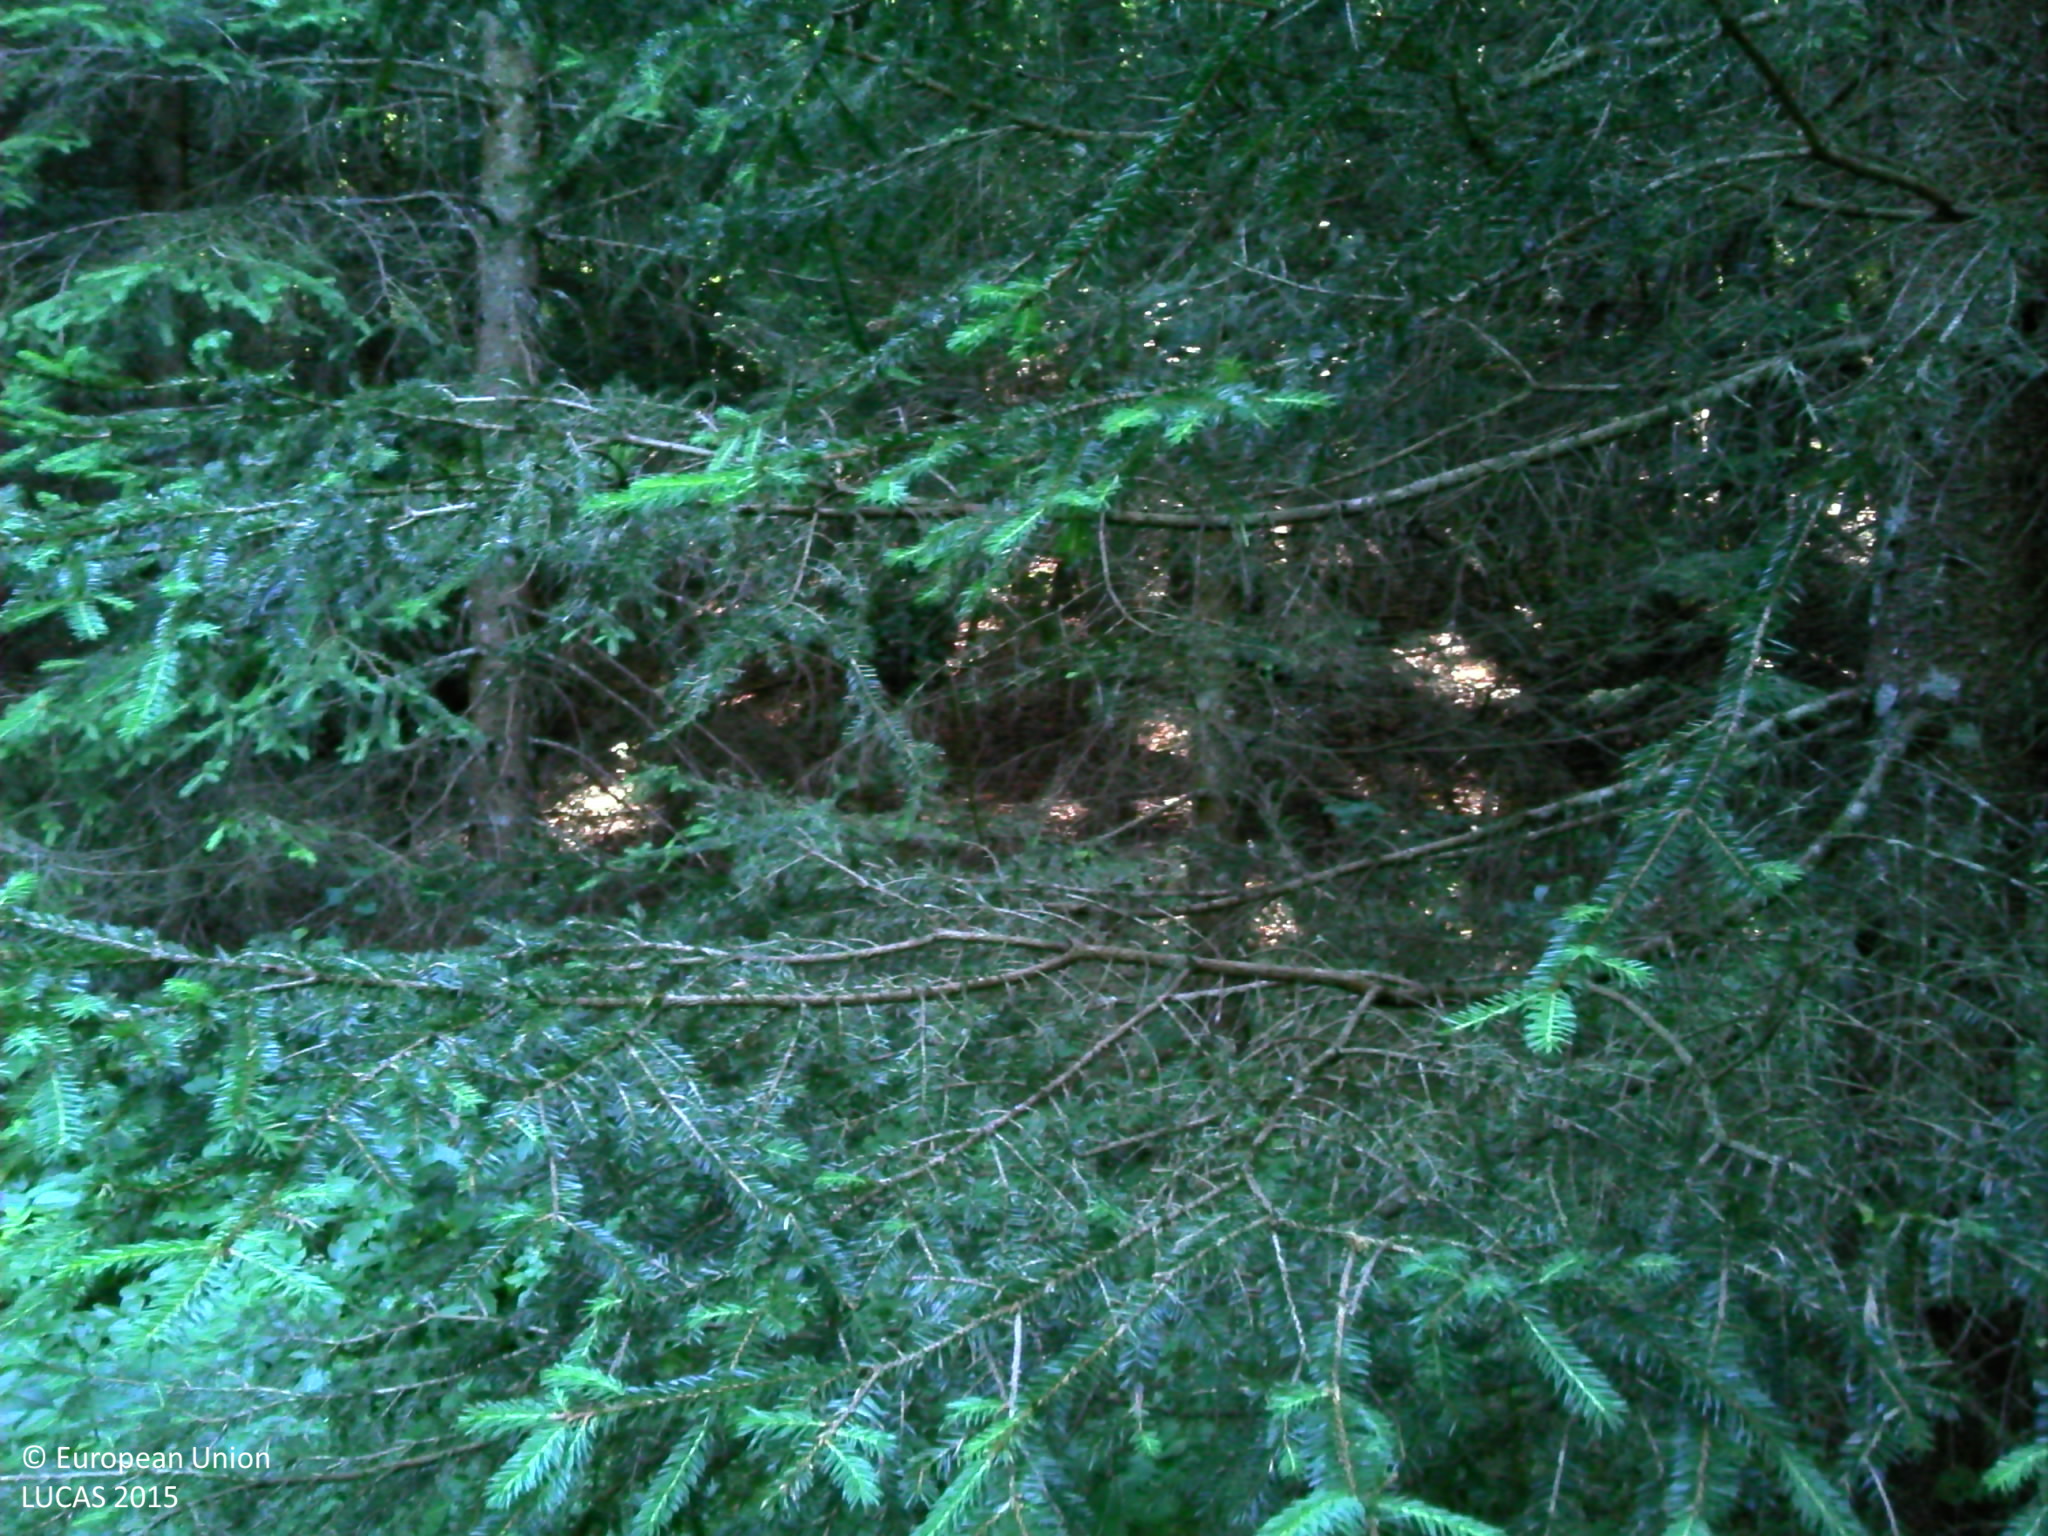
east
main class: Woodland
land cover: Spruce dominated coniferous woodland
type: alpine coniferous forest
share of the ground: > 75 %
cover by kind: coniferous forest trees 60 %, herbaceous plants 20 %, lichens and mosses 20 %
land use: Forestry
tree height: > 5 m
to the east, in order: Spruce dominated coniferous woodland; Broadleaved woodland; Tracks; Broadleaved woodland
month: July
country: FR
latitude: 46.6397
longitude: 6.0705
